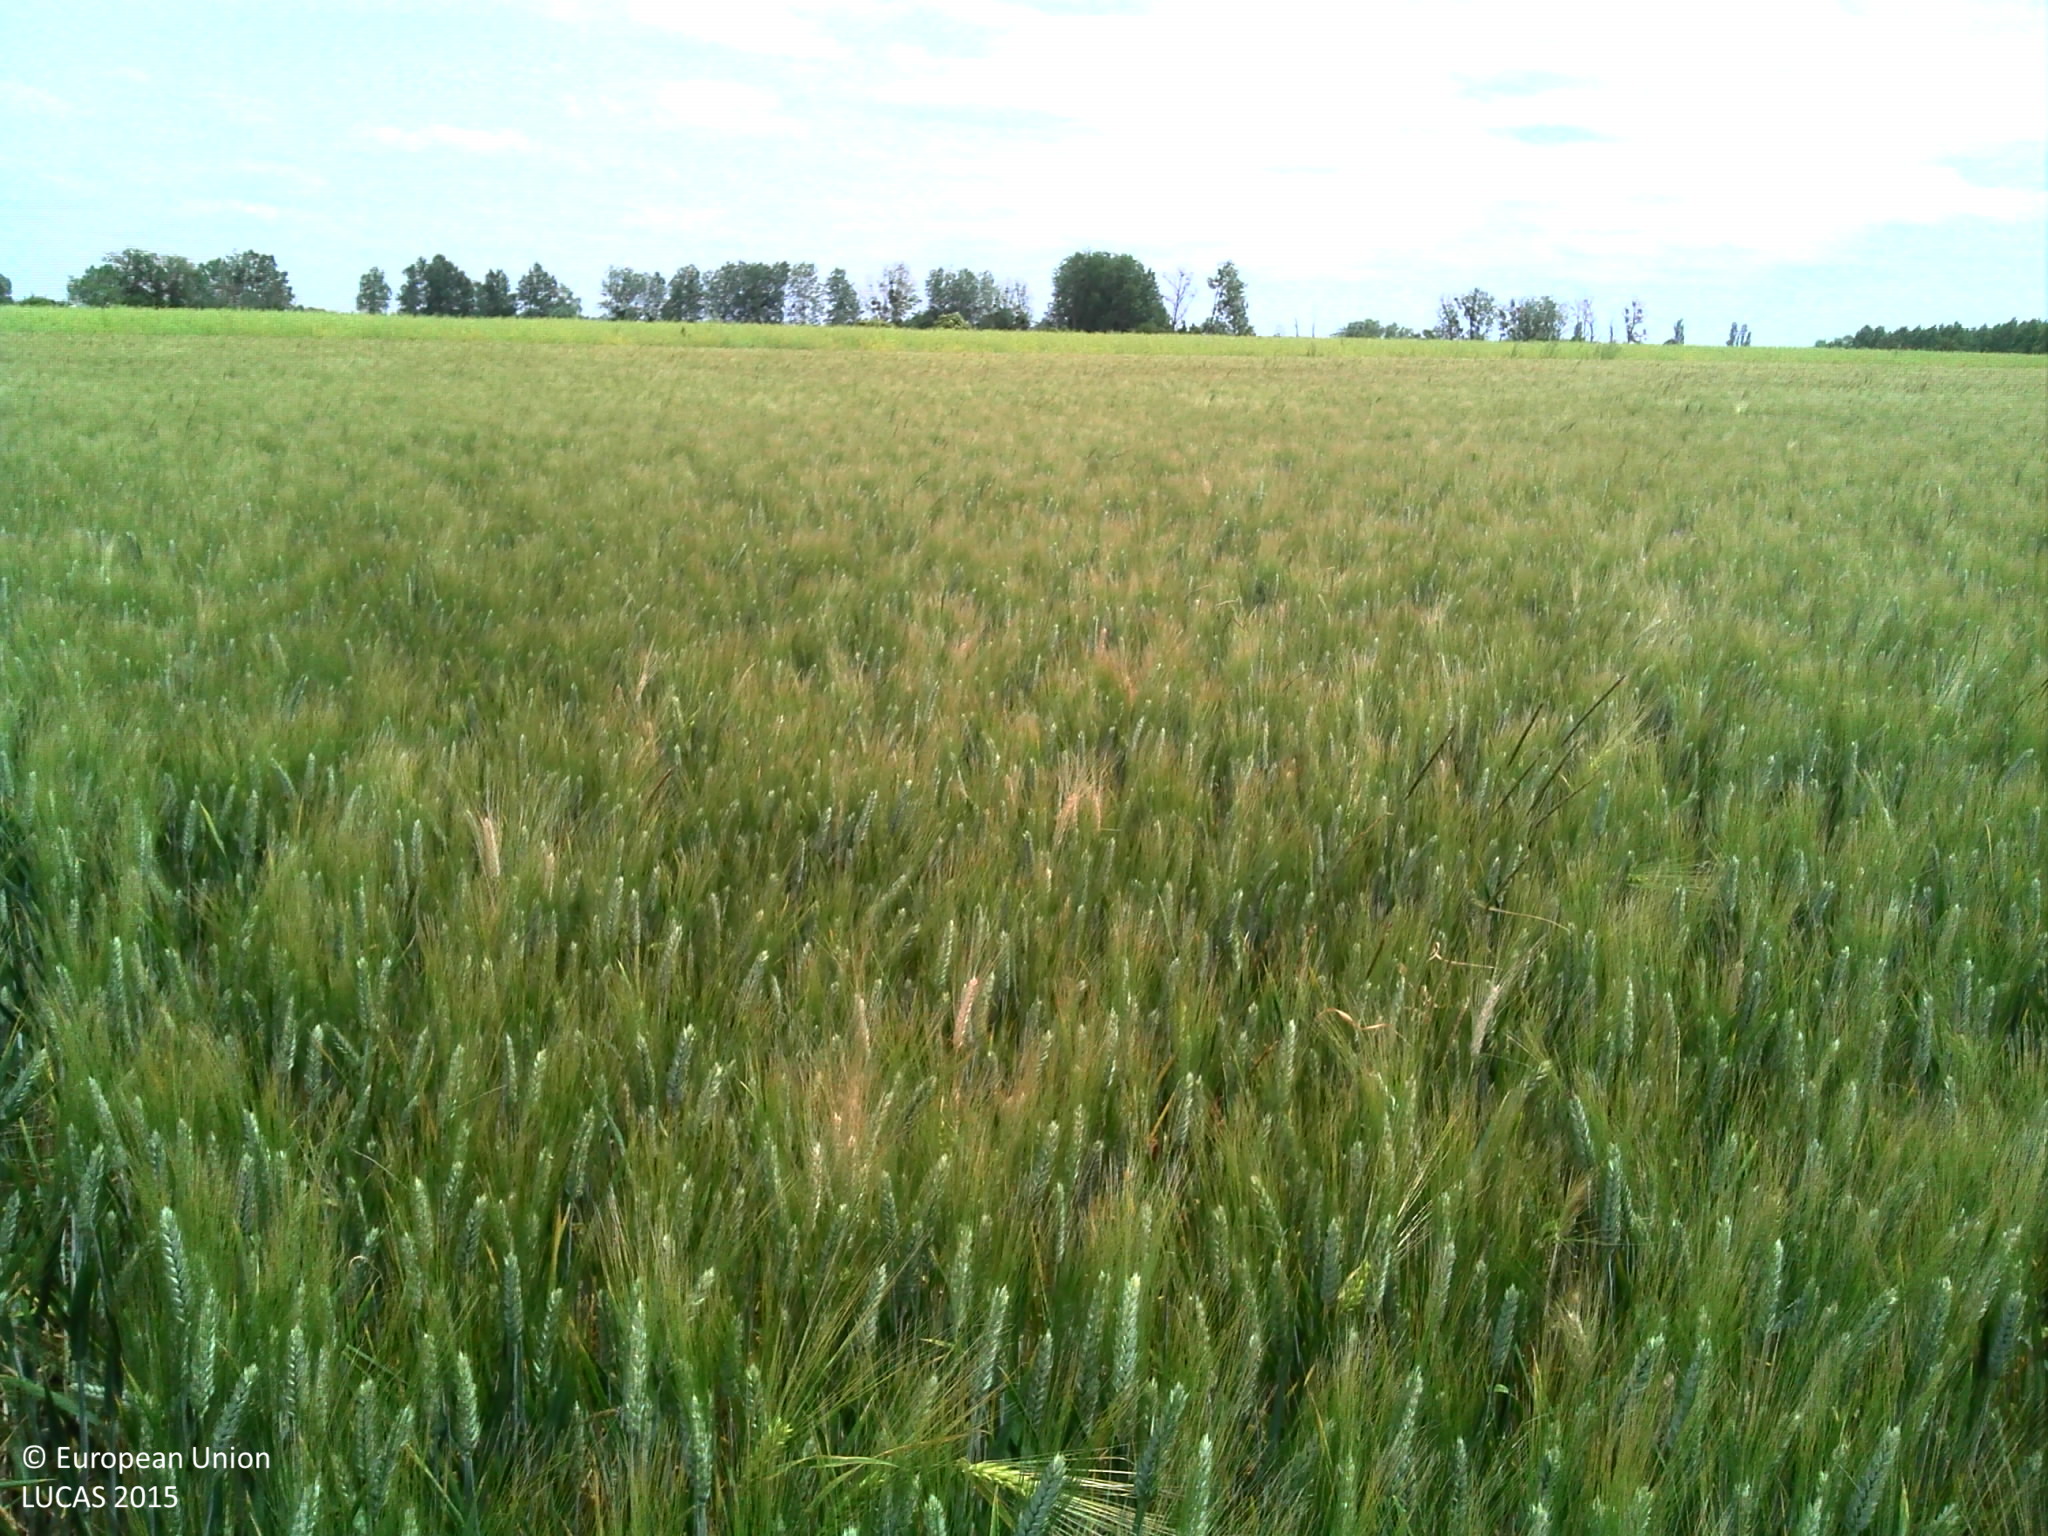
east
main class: Cropland
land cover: Common wheat
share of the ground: > 75 %
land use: Agriculture (excluding fallow land and kitchen gardens)
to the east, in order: Common wheat; Rape and turnip rape
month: June
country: FR
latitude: 46.9300
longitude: 2.6525
